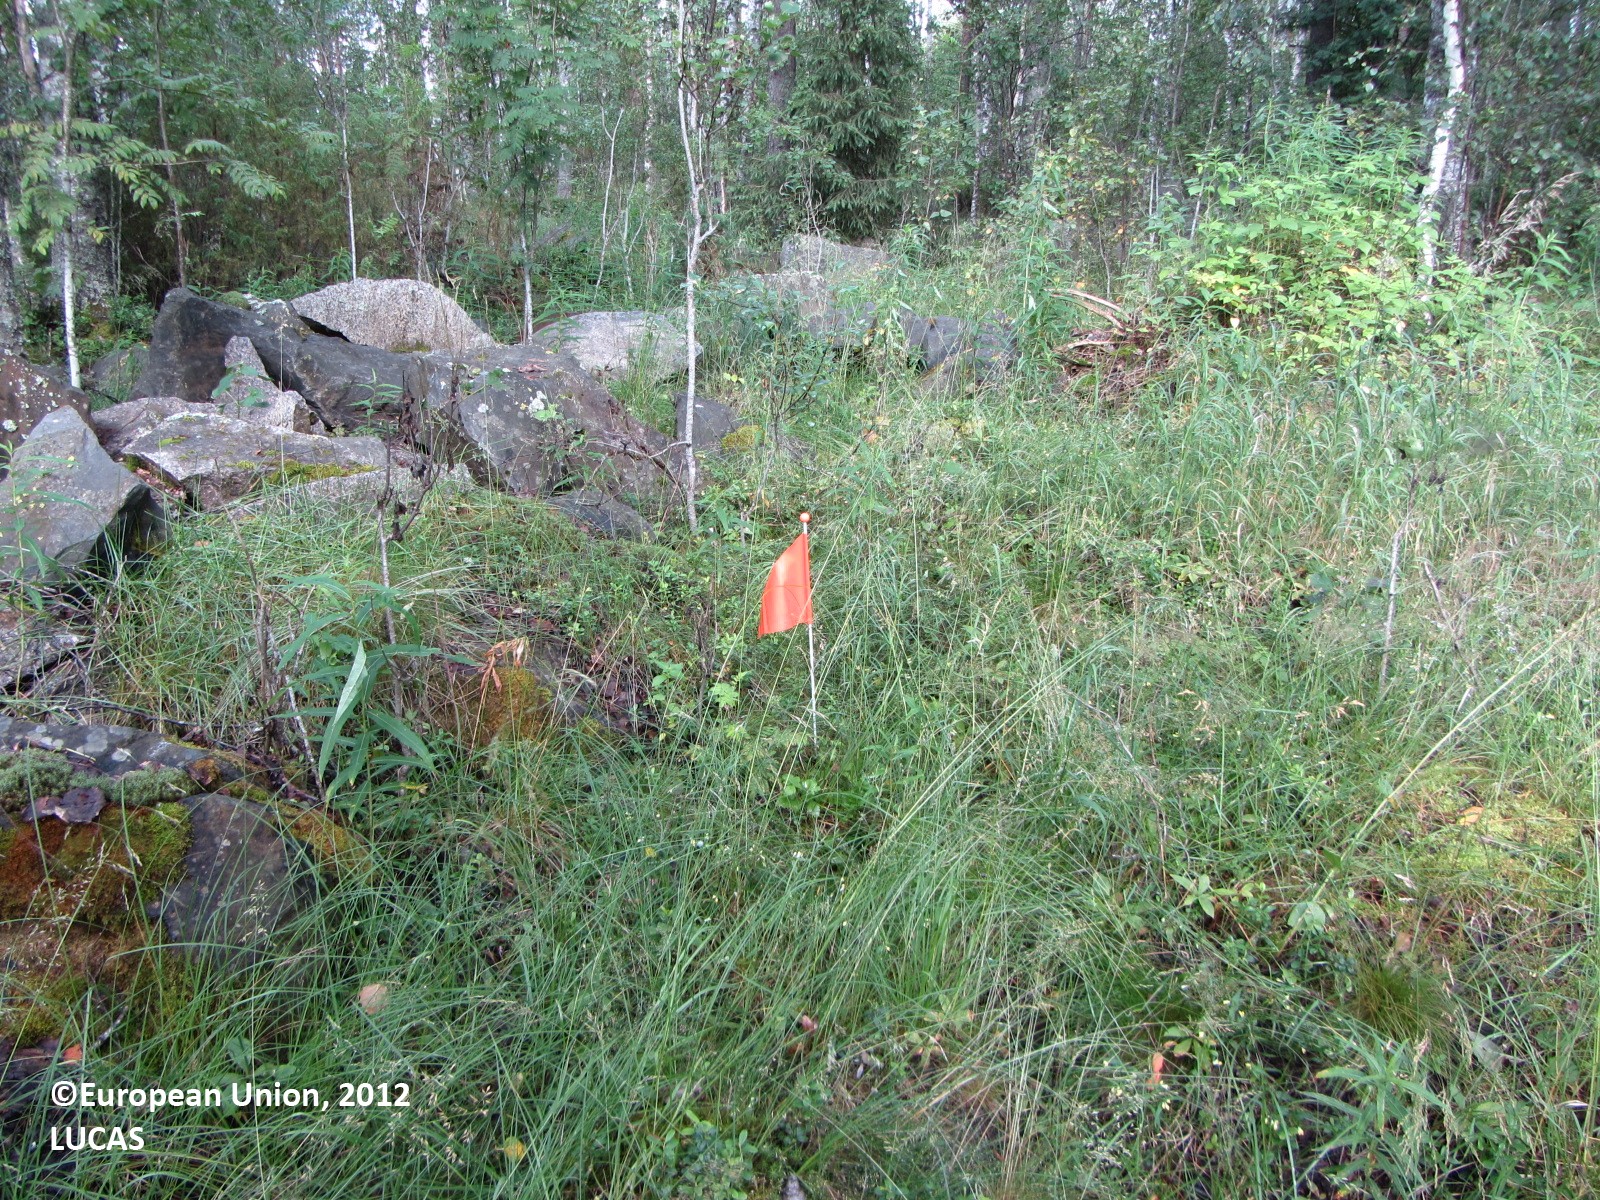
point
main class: Woodland
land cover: Broadleaved woodland
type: boreal forest
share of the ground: 50 - 75 %
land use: Forestry
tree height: > 5 m
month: July
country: FI
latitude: 63.8591
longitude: 24.6657
